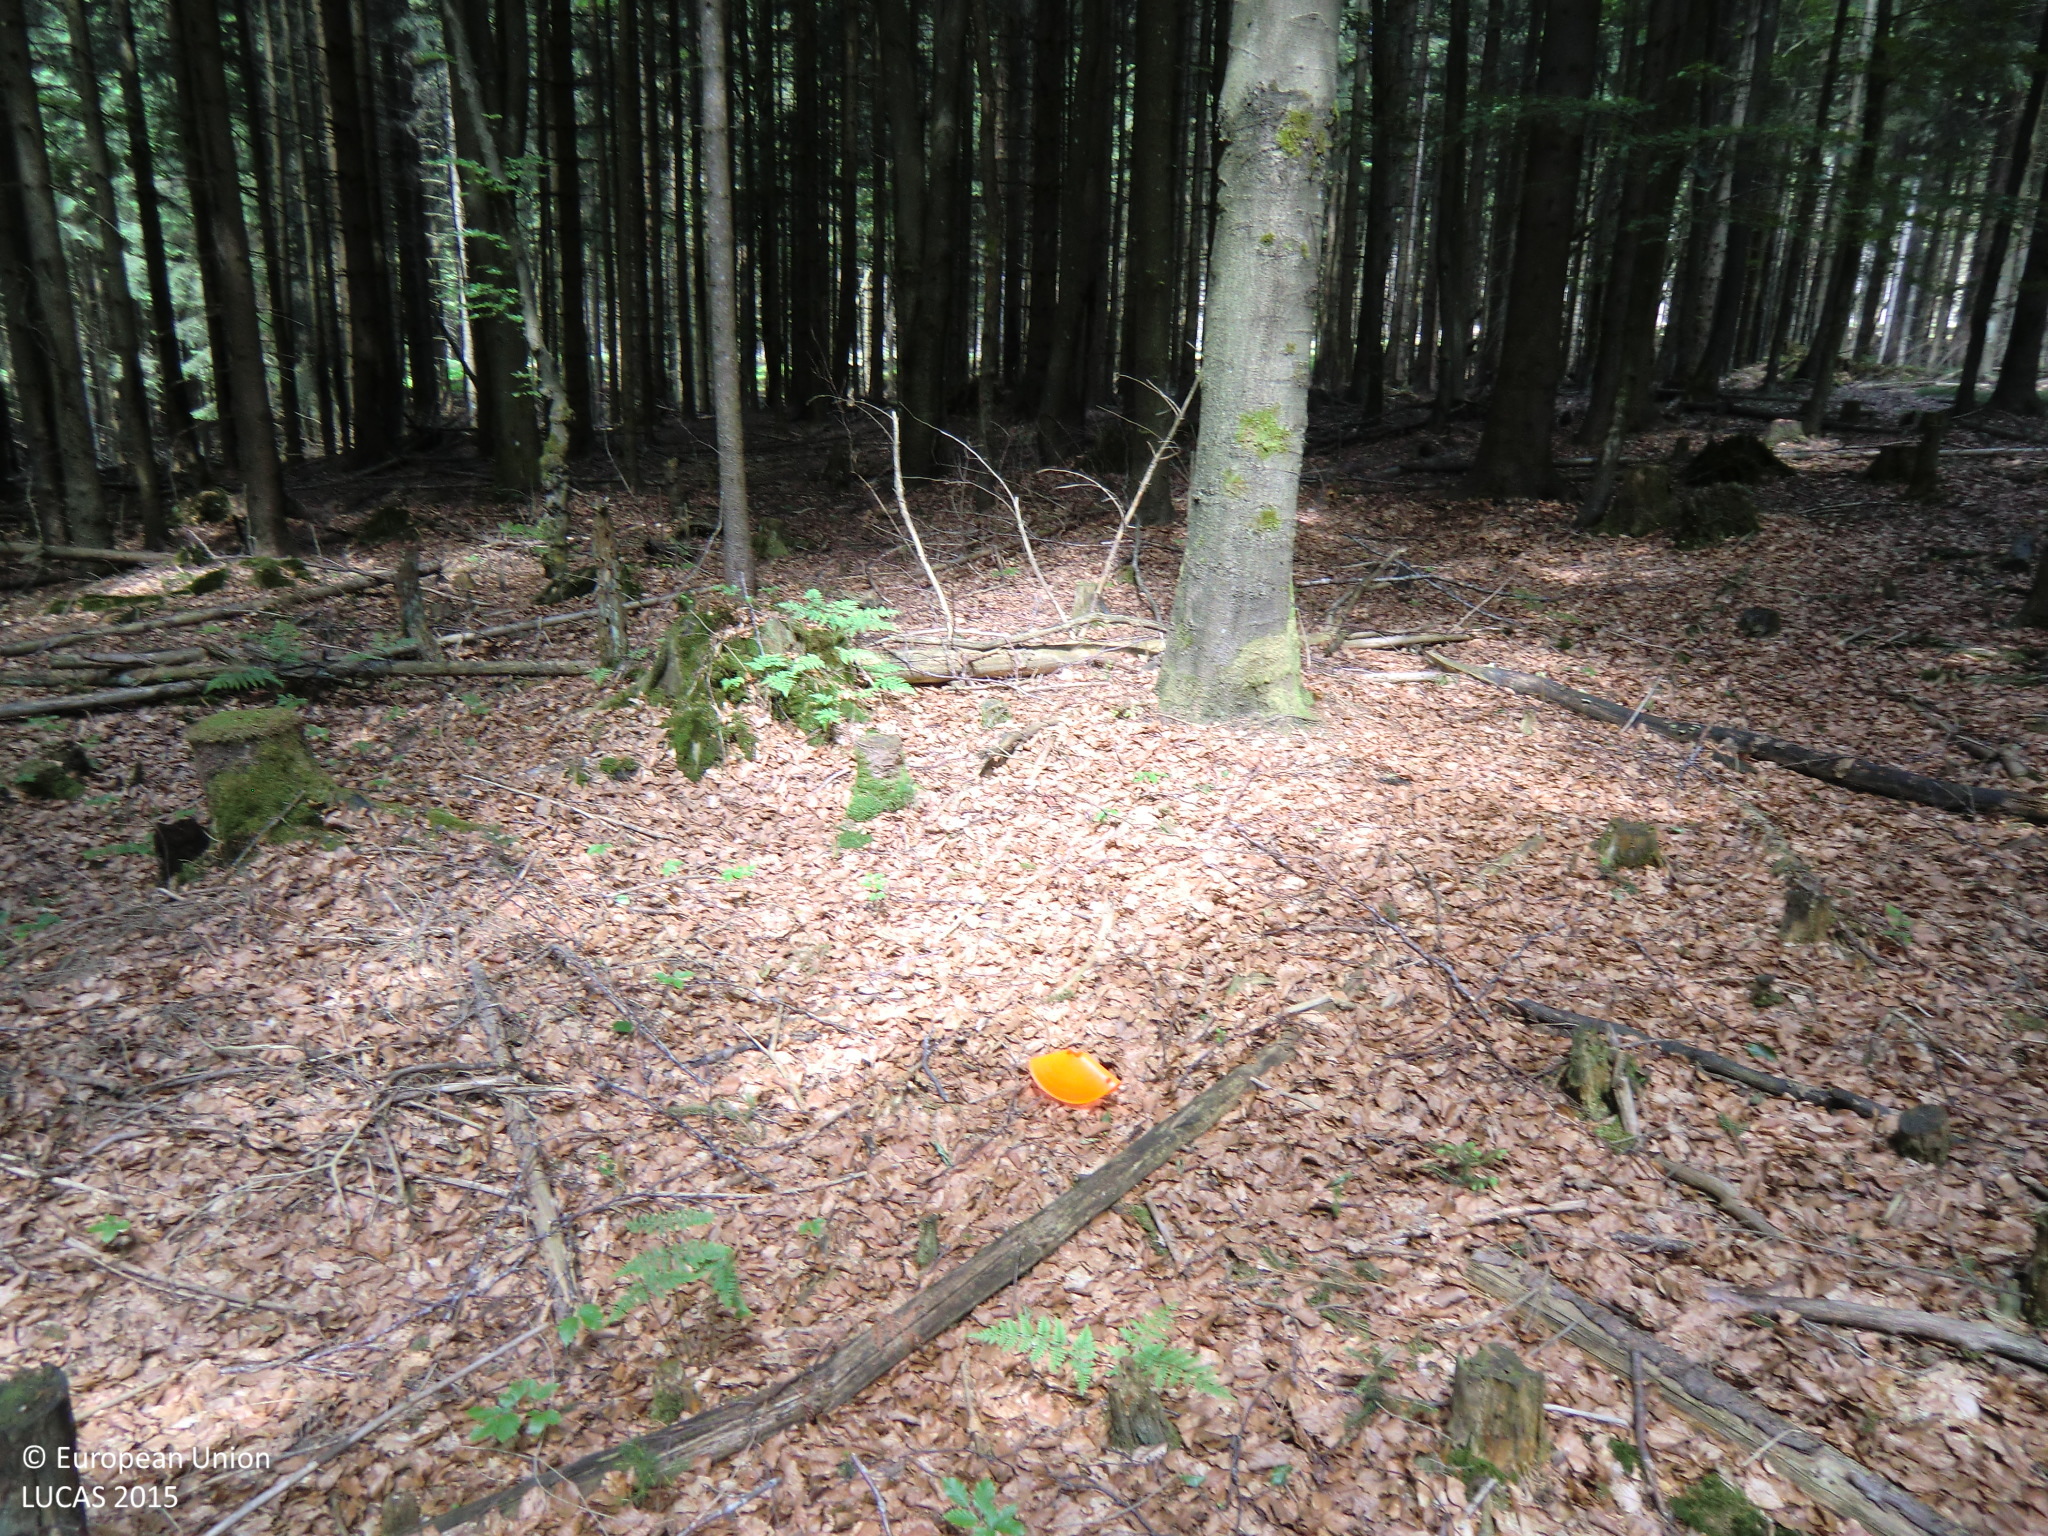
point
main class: Woodland
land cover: Spruce dominated mixed woodland
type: hemiboreal forest and nemoral coniferous forest and mixed broadleaved-coniferous forest
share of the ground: > 75 %
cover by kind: coniferous forest trees 45 %, broadleaved forest trees 45 %, consolidated bare surface 10 %
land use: Forestry
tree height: > 5 m
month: June
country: AT
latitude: 48.3633
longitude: 14.9819
